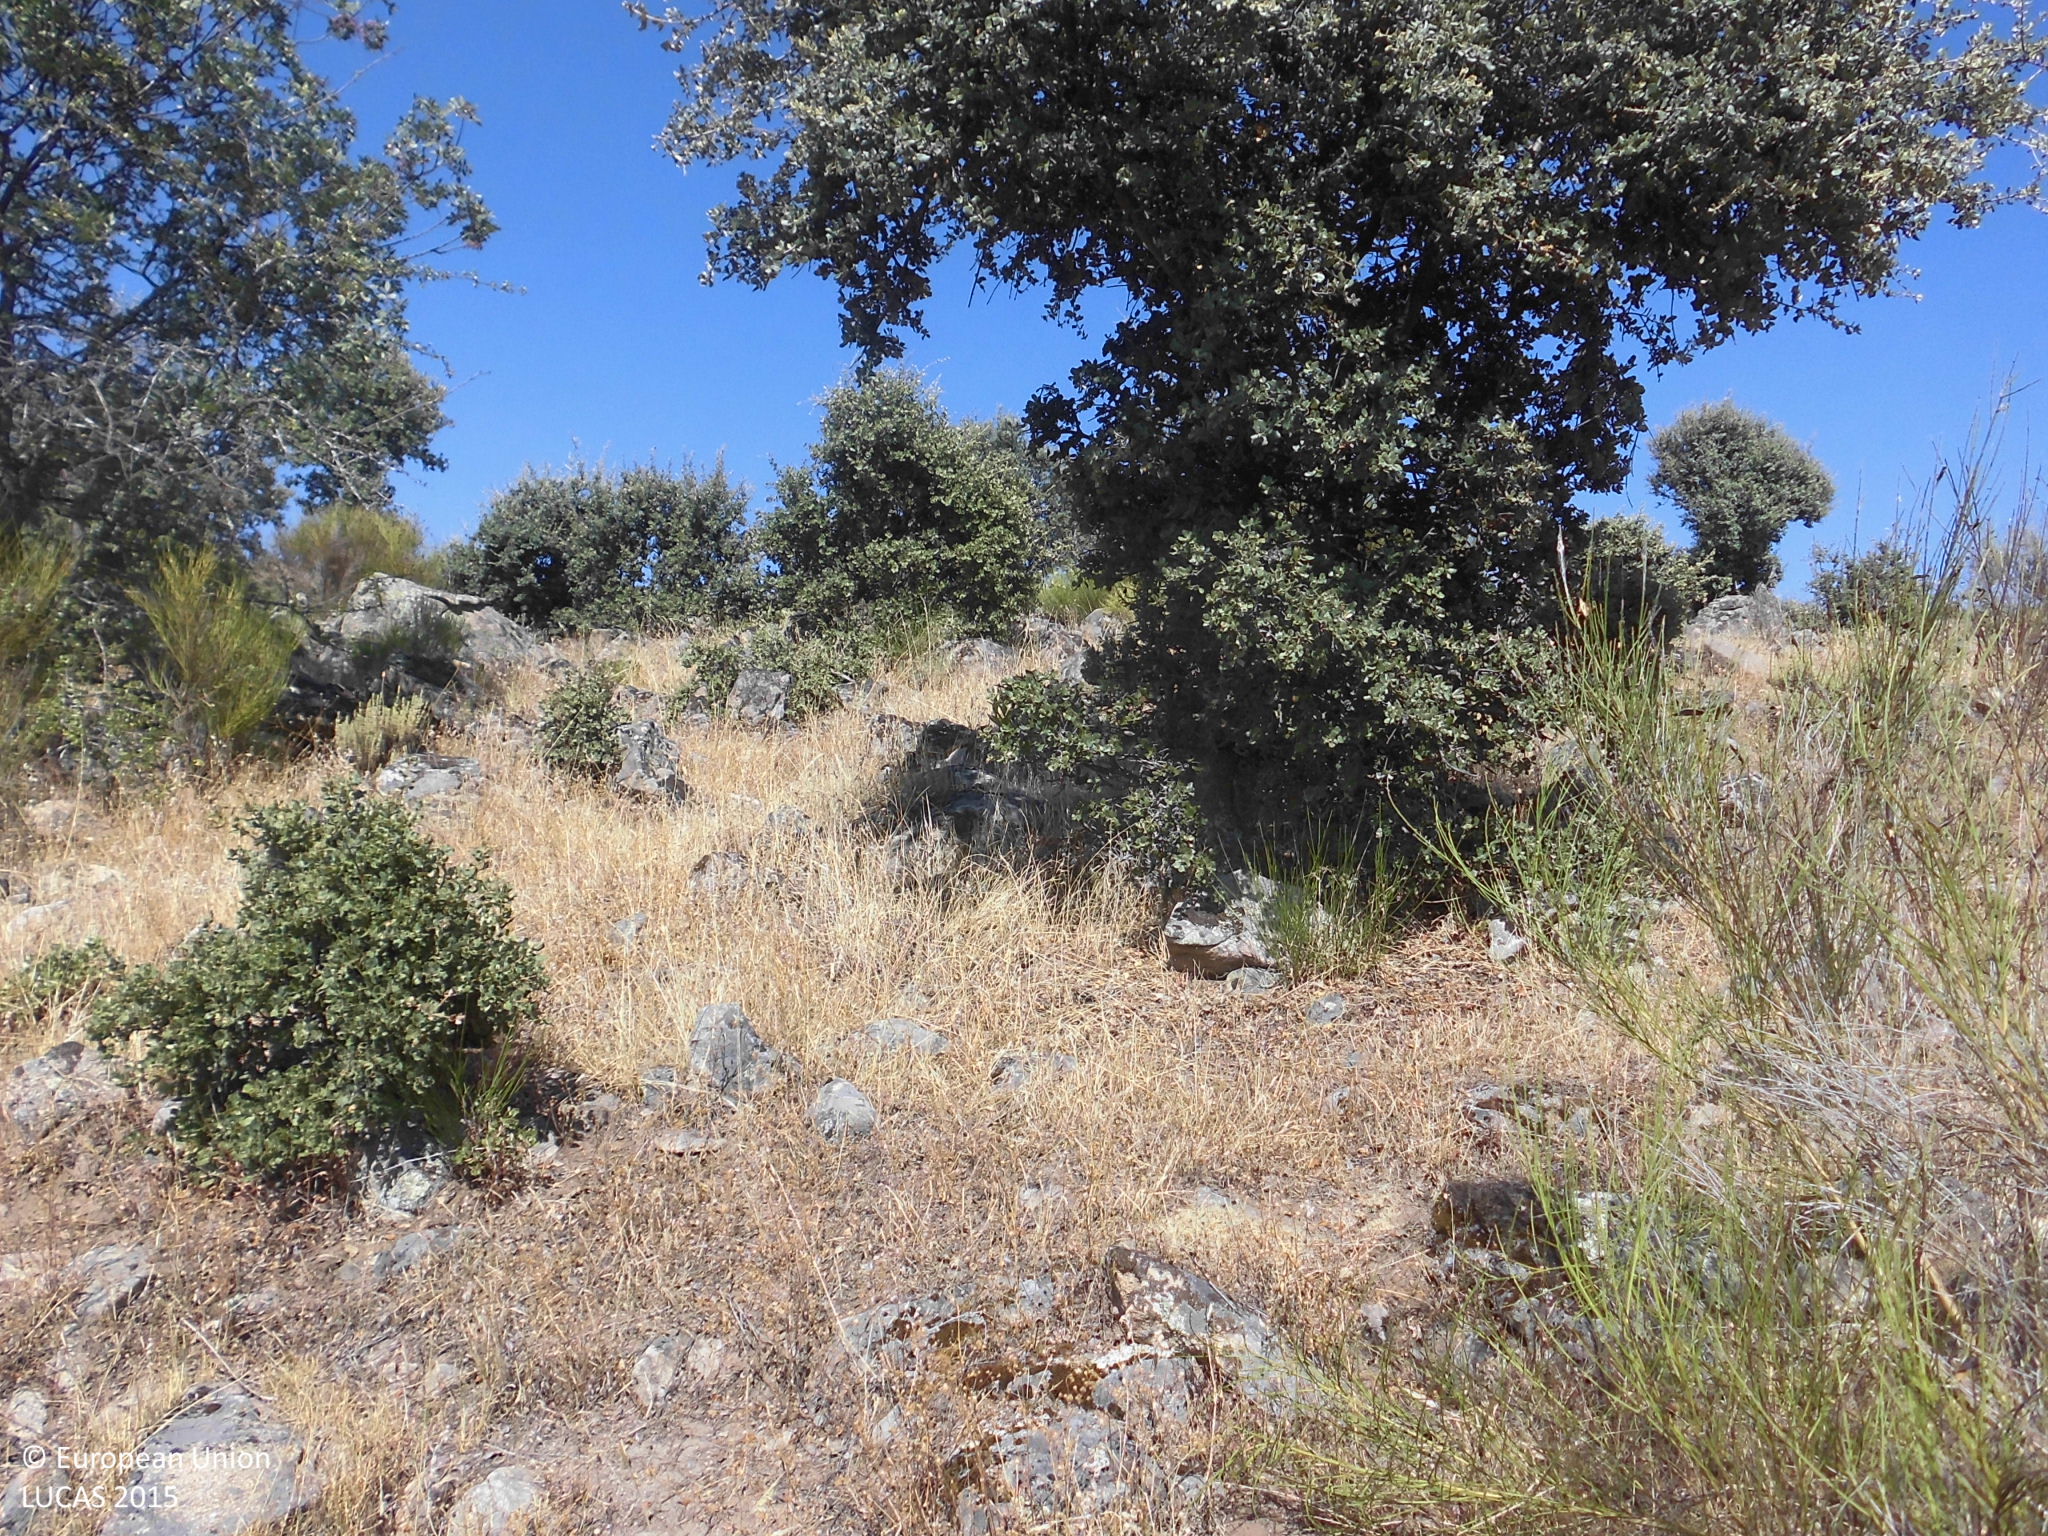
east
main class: Shrubland
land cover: Shrubland with sparse tree cover
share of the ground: 10 - 25 %
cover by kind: herbaceous plants 70 %, shrubs 25 %, broadleaved forest trees 5 %
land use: Agriculture (excluding fallow land and kitchen gardens)
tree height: > 5 m
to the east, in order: Shrubland with sparse tree cover; Broadleaved woodland; Rivers and streams; Shrubland with sparse tree cover
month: July
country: ES
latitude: 40.1155
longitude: -6.0406
